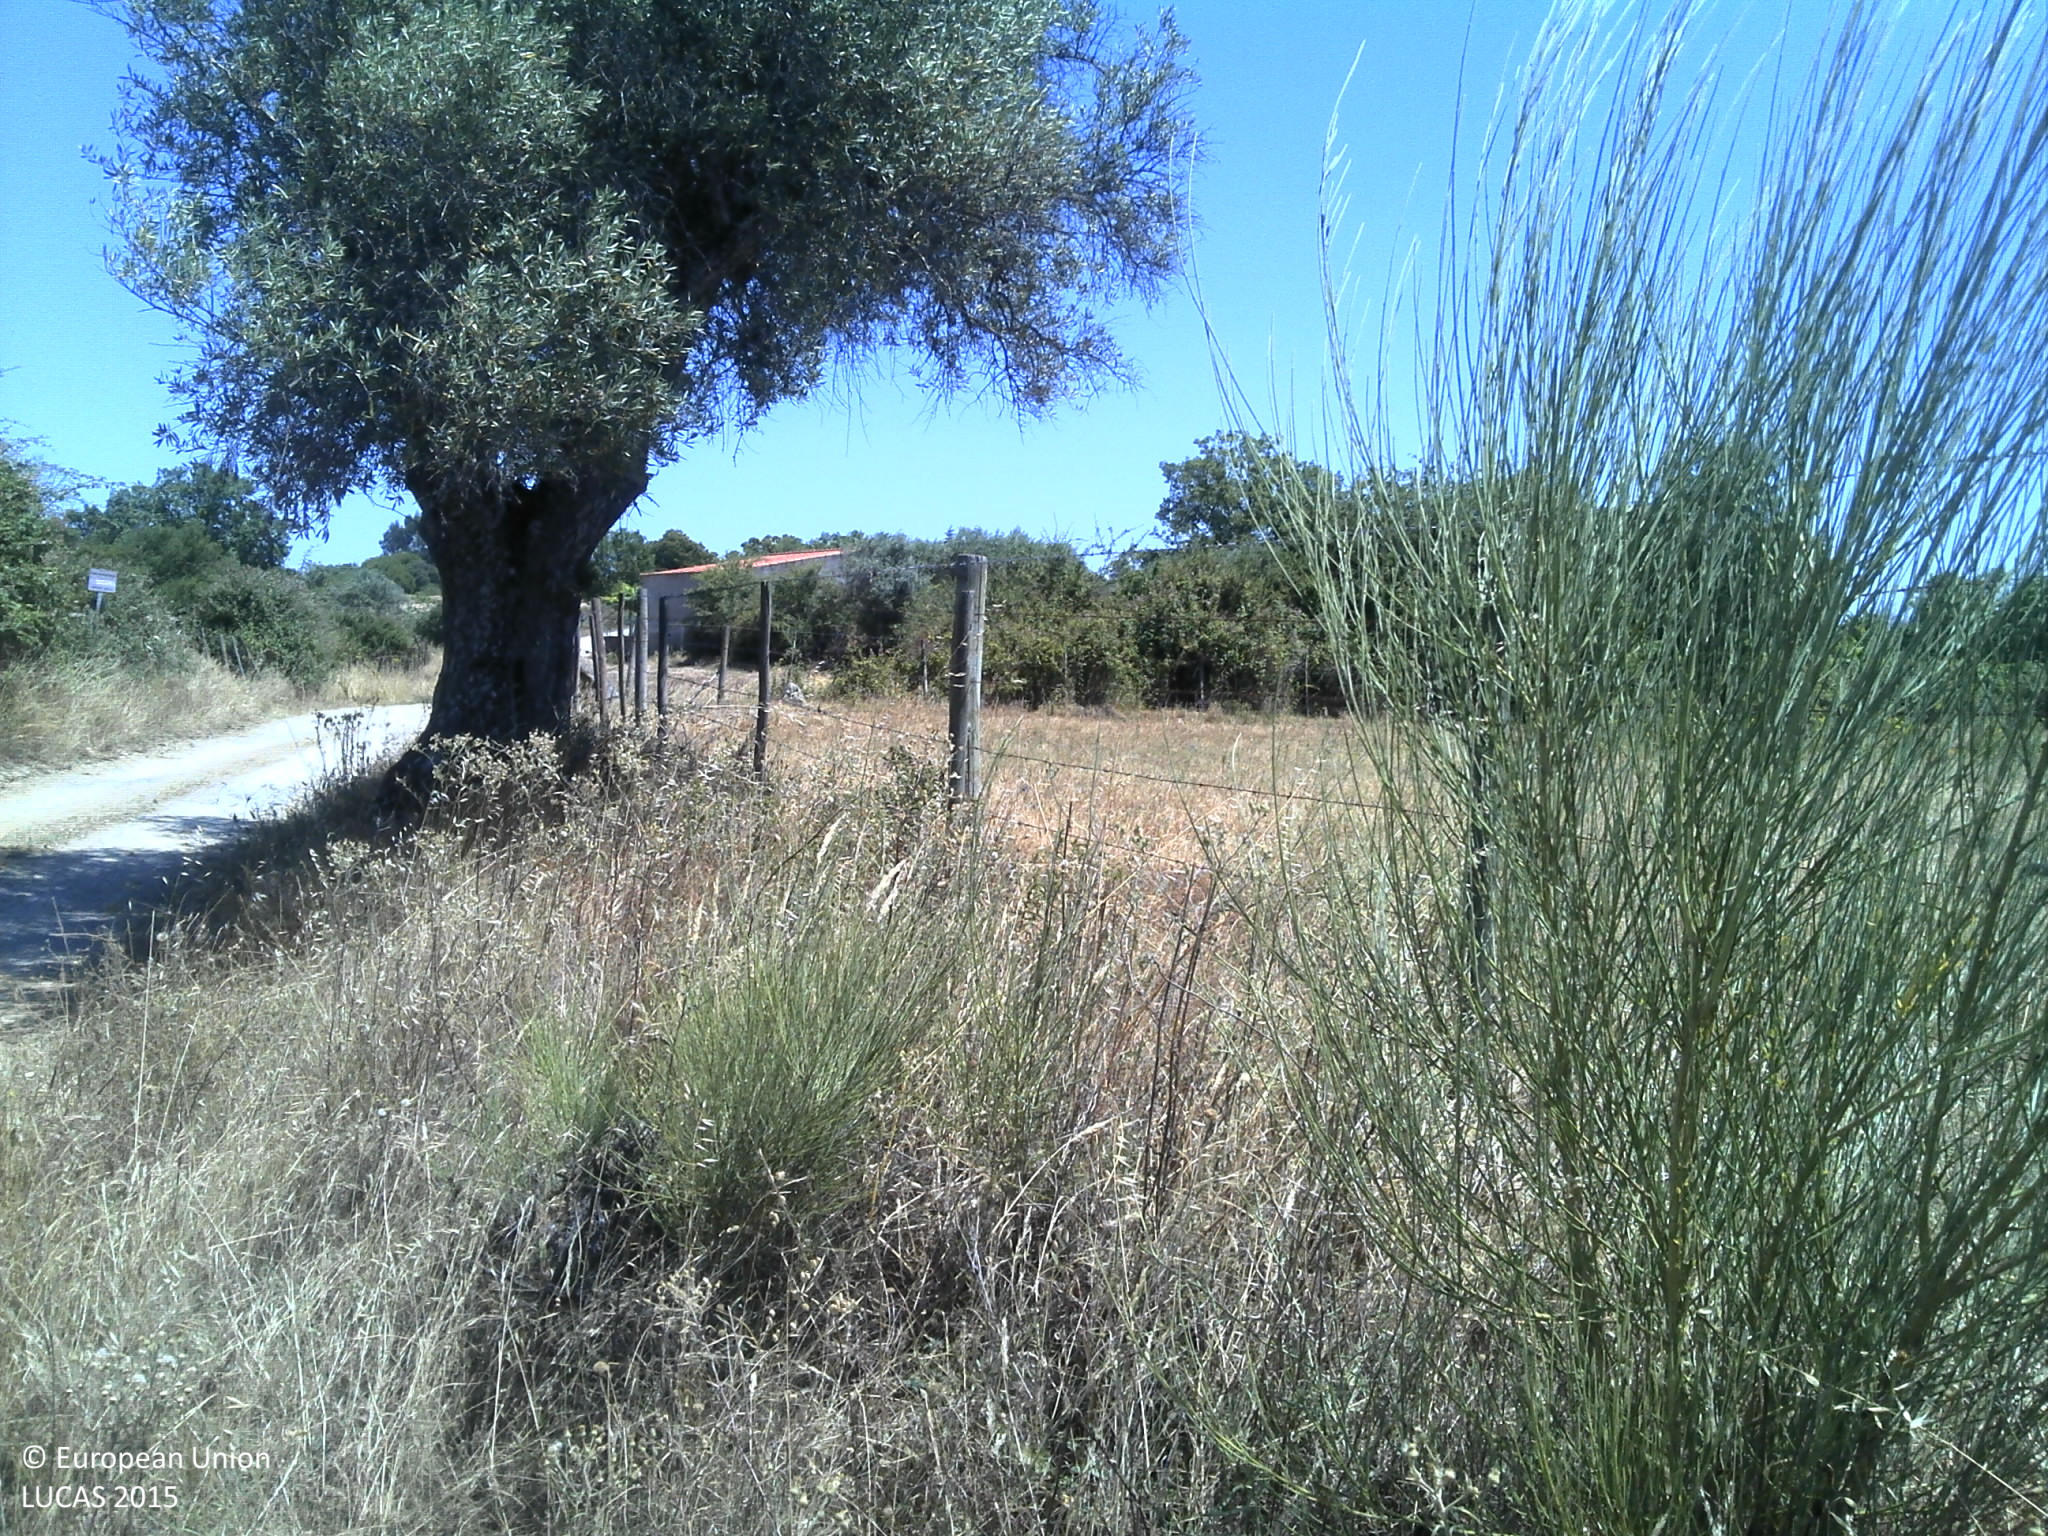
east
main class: Grassland
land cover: Grassland without tree/shrub cover
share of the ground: 50 - 75 %
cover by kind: herbaceous plants 65 %, unconsolidated bare surface 30 %
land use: Agriculture (excluding fallow land and kitchen gardens)
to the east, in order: Grassland without tree/shrub cover; Tracks; Grass margins; Fences; Grassland without tree/shrub cover; Fences; Ditches and canals; Grassland without tree/shrub cover; Fences; Tracks; Dry stone walls; Fences; Grassland without tree/shrub cover; Olive groves; Abandoned hedges; Grassland without tree/shrub cover; Abandoned hedges; Rivers and streams; Shruby margins; Grassland without tree/shrub cover
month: June
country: PT
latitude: 40.1119
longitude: -7.2391
